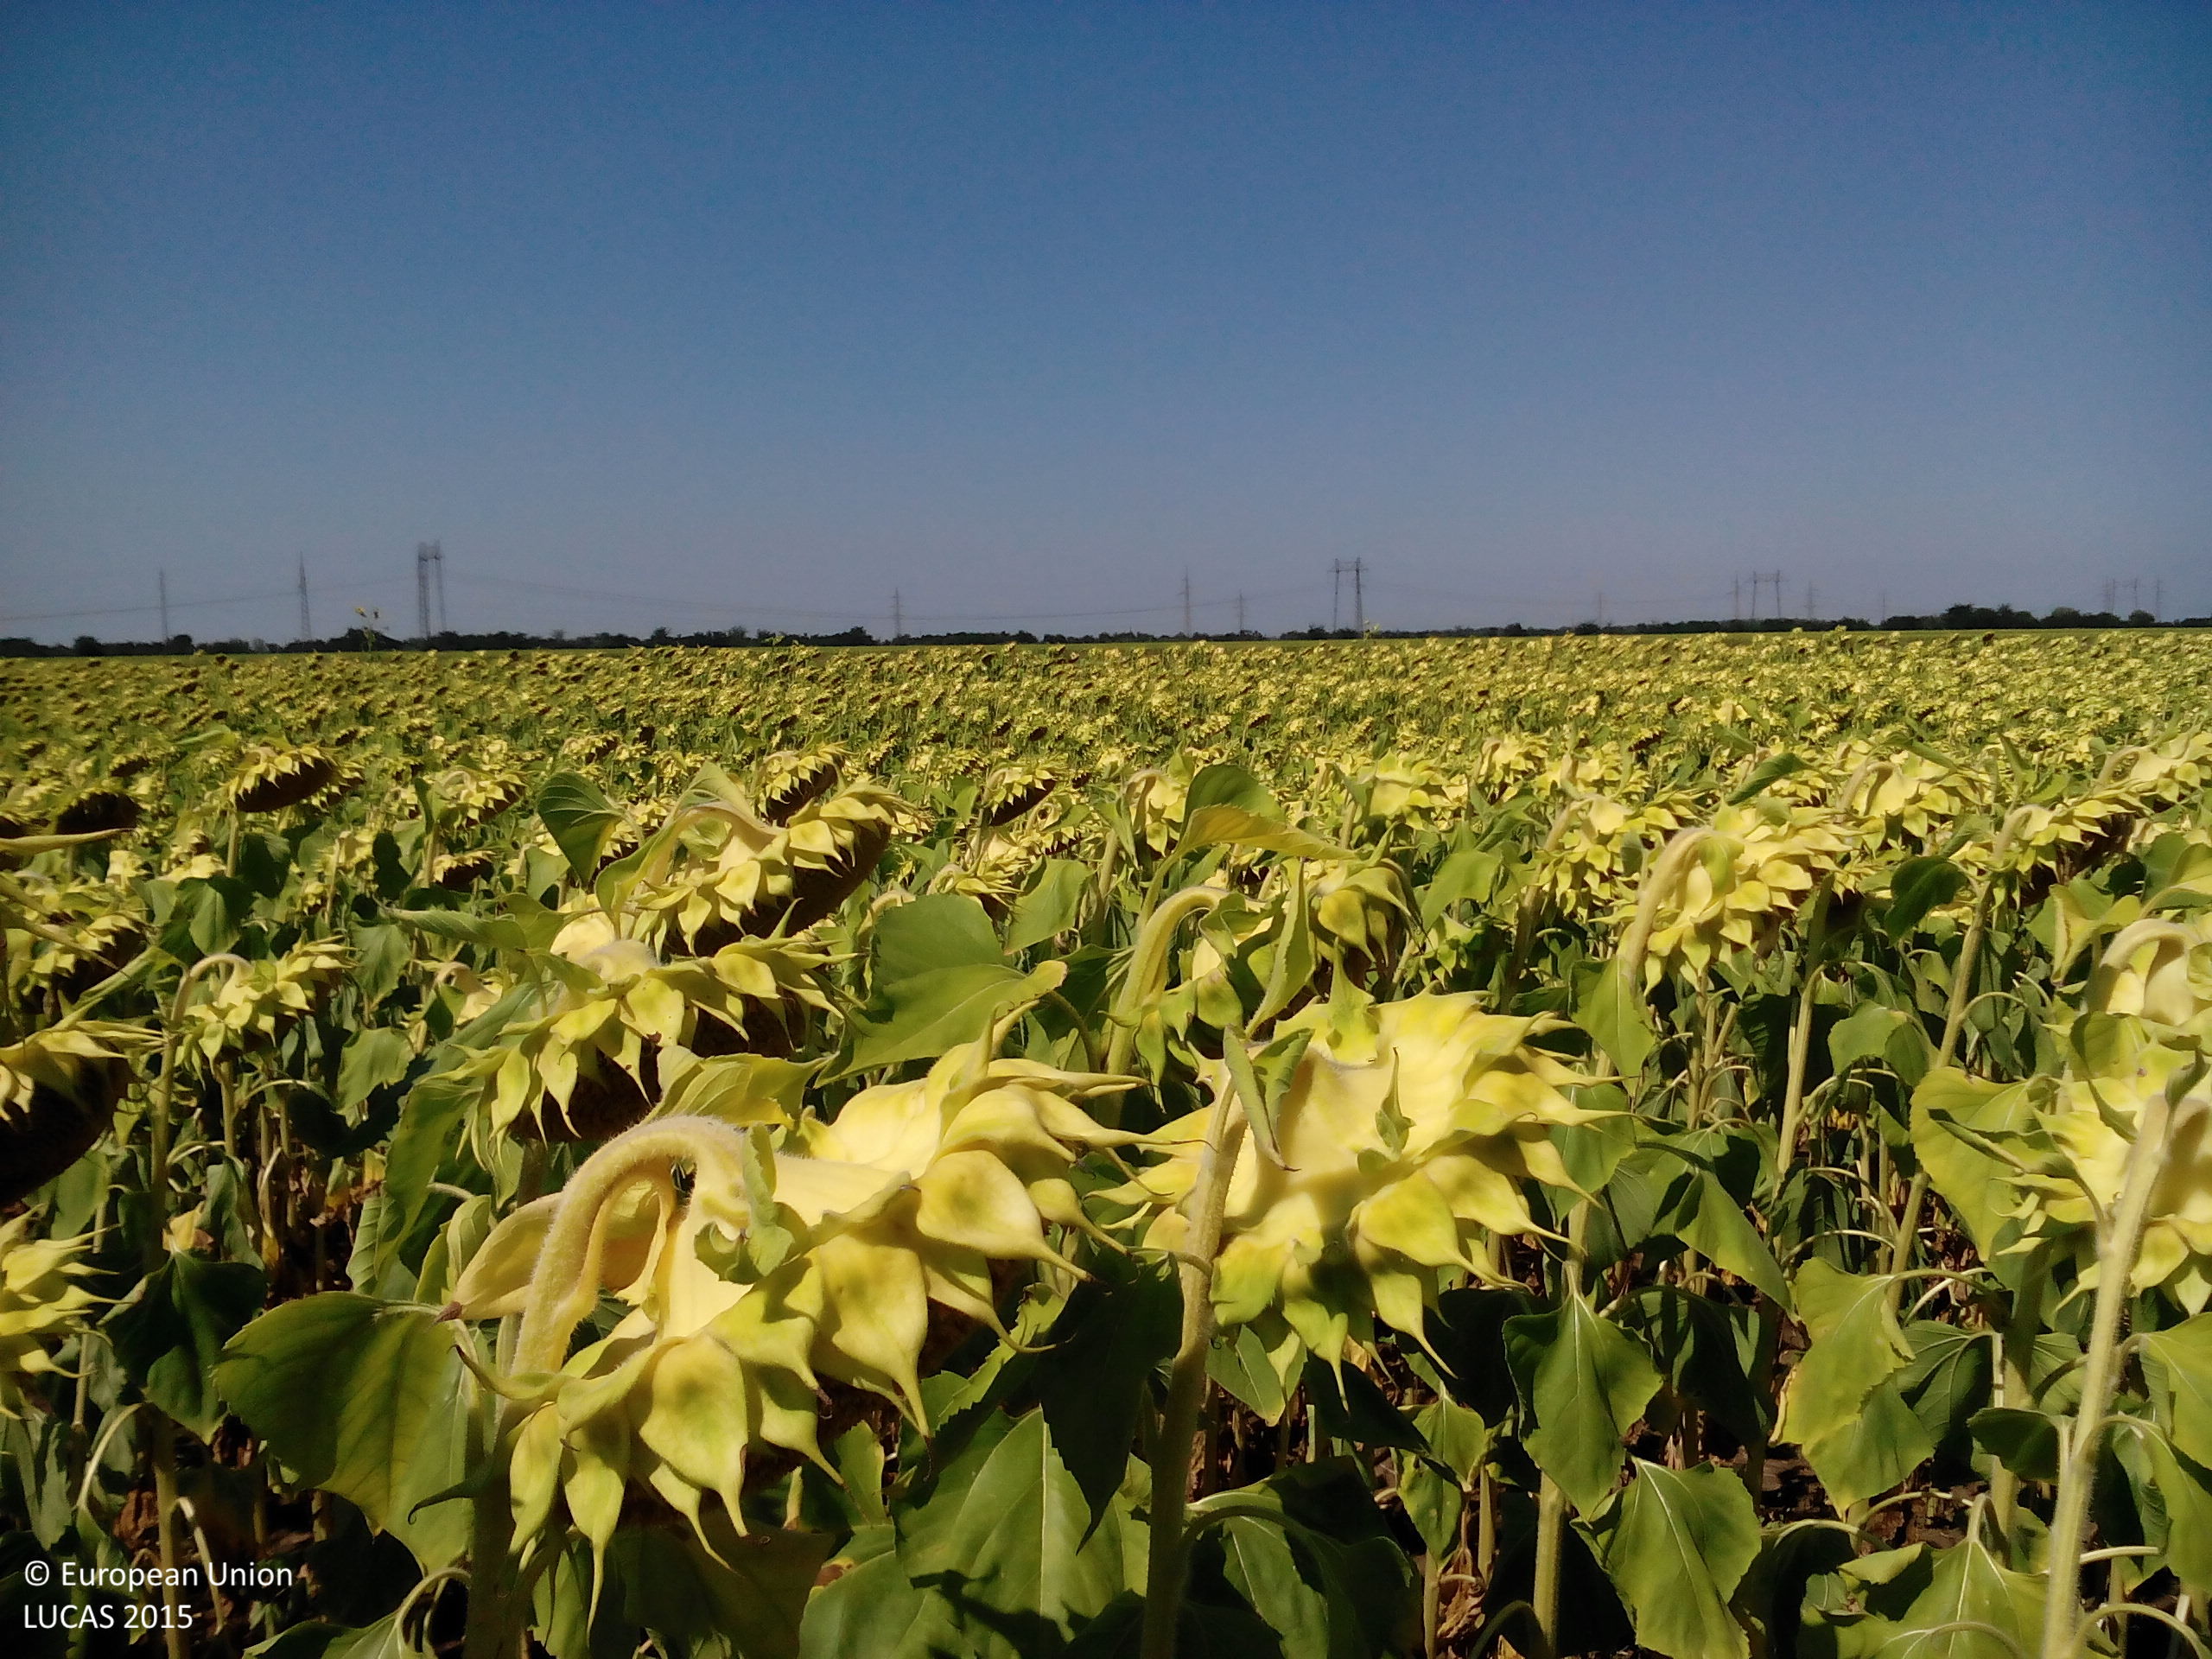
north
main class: Cropland
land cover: Sunflower
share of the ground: > 75 %
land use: Agriculture (excluding fallow land and kitchen gardens)
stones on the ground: < 10 %
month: July
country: BG
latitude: 43.3145
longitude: 24.3221
